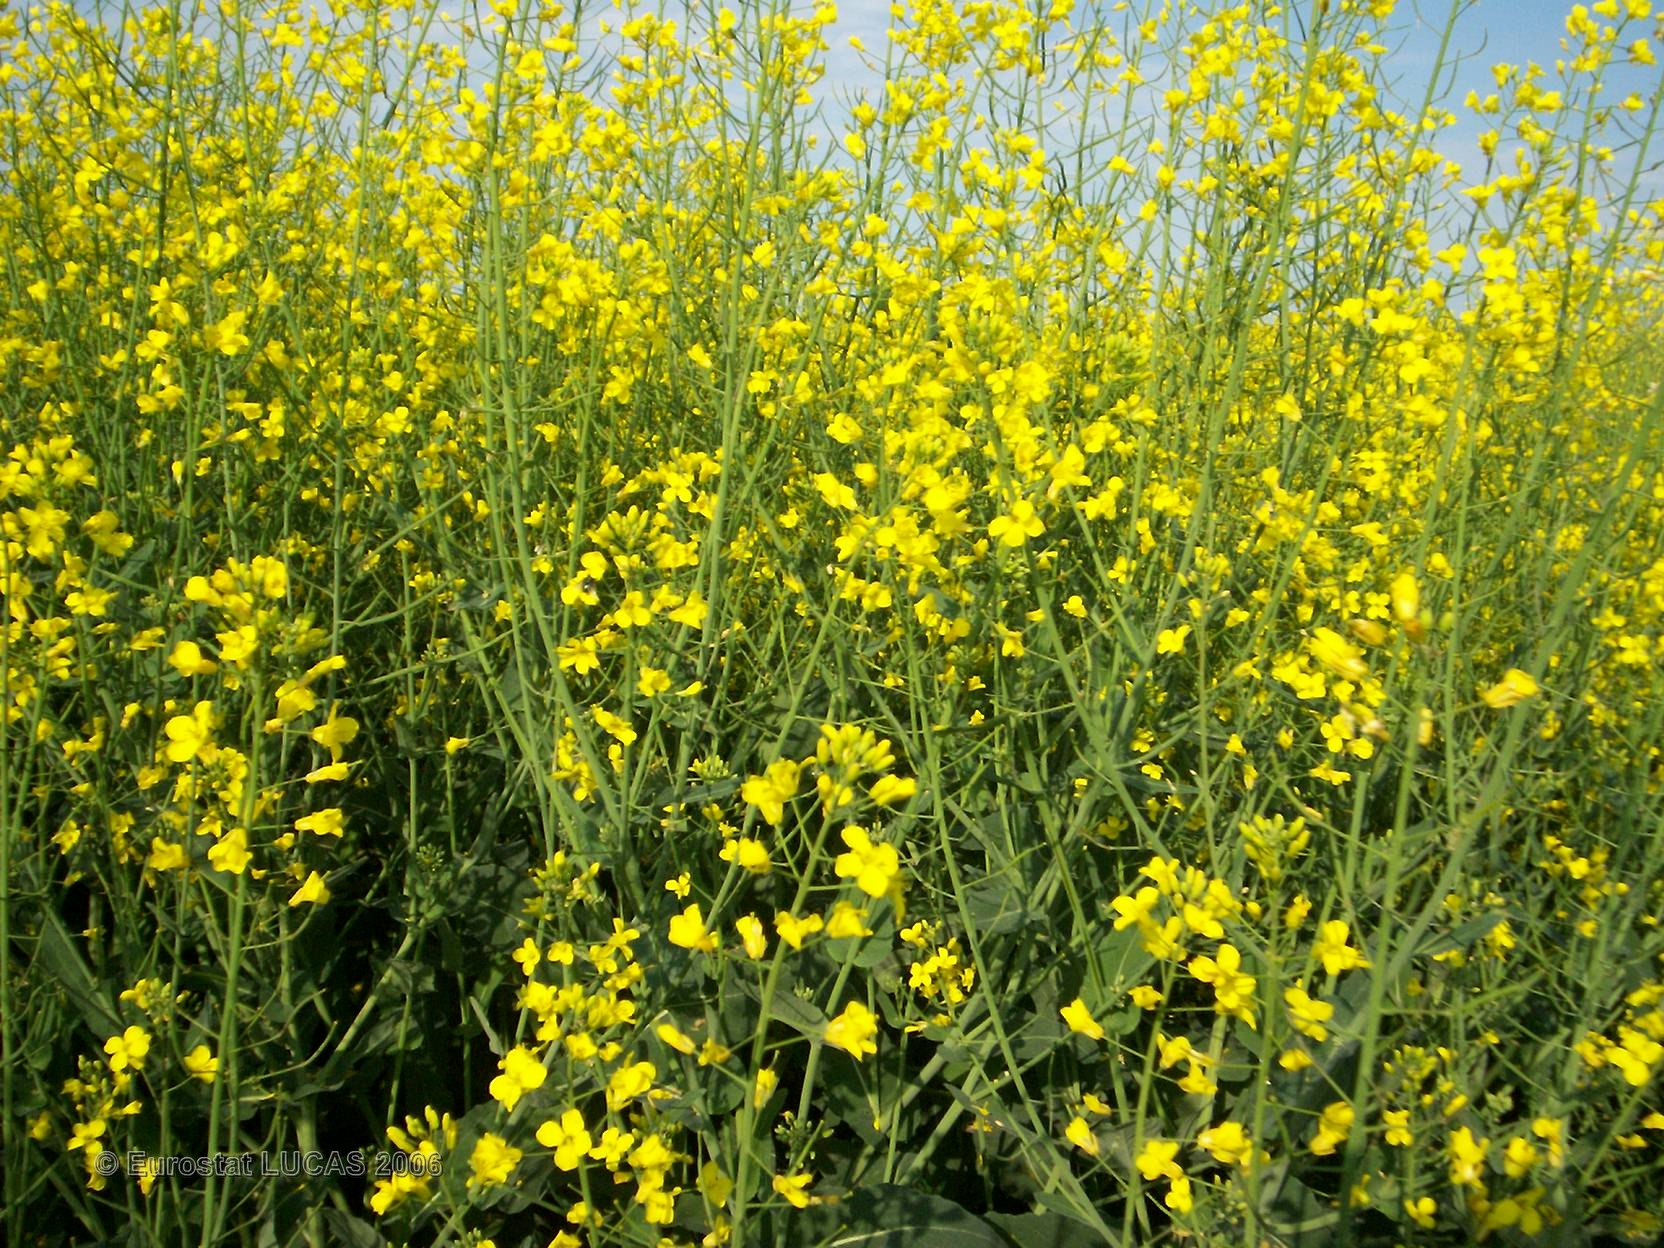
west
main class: Cropland
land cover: Vineyards
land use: Agriculture (excluding fallow land and kitchen gardens)
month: May
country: FR
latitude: 45.5895
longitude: -0.7532
